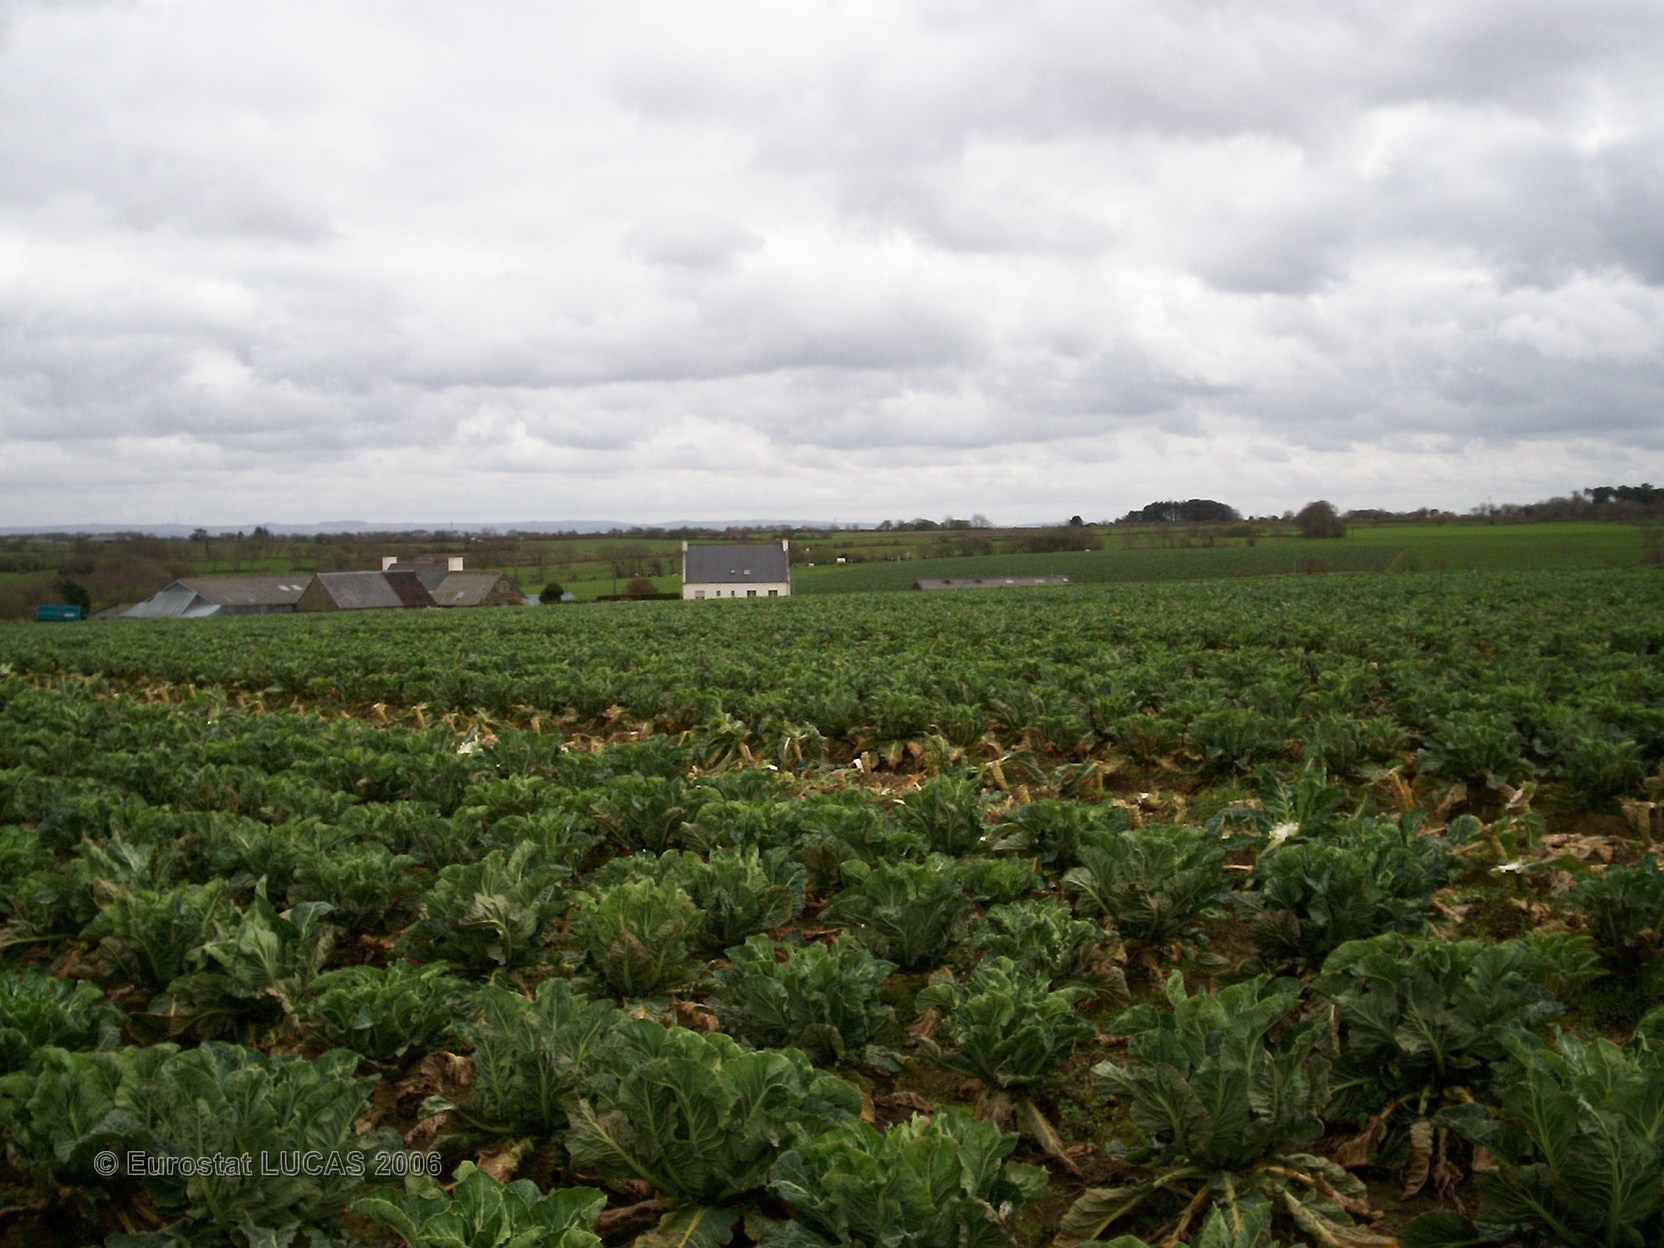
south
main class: Cropland
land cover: Other fresh vegetables
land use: Agriculture (excluding fallow land and kitchen gardens)
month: April
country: FR
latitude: 48.5445
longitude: -4.0278
